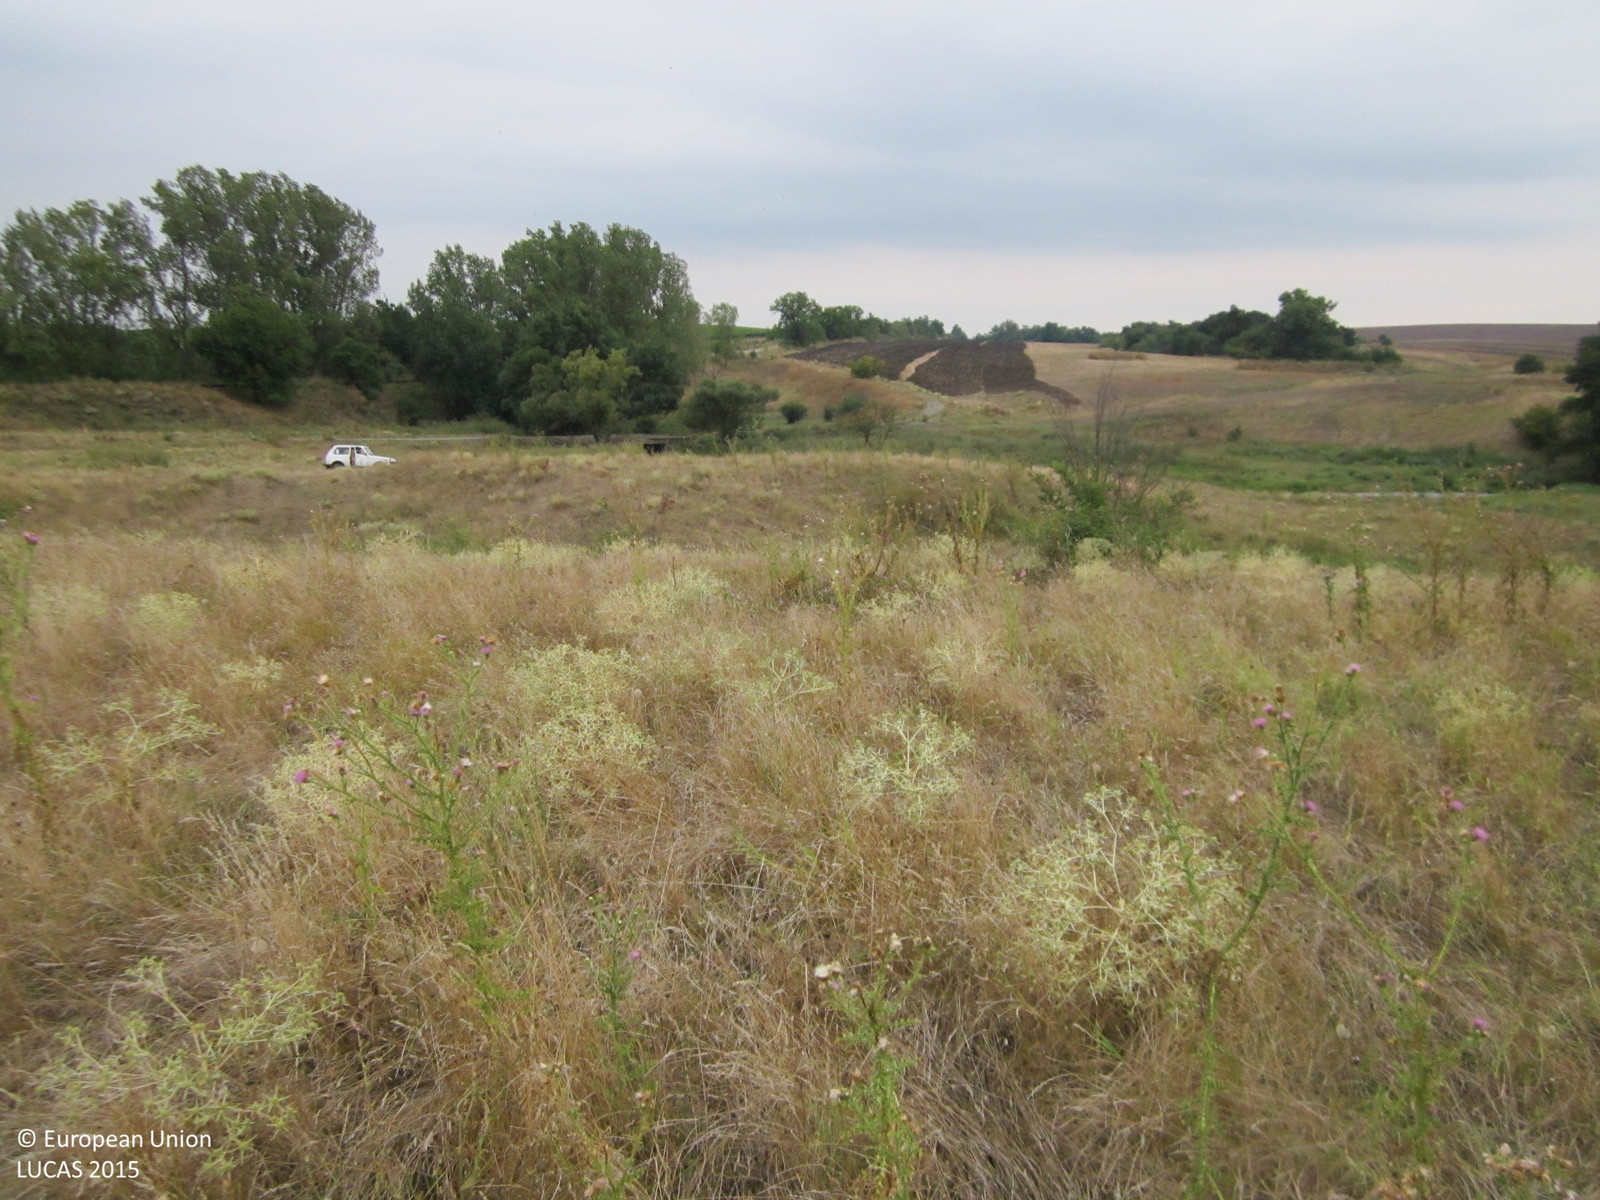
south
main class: Grassland
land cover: Grassland without tree/shrub cover
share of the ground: > 75 %
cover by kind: herbaceous plants 95 %, shrubs 5 %
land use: Agriculture (excluding fallow land and kitchen gardens)
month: August
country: BG
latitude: 42.4967
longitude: 26.9810
